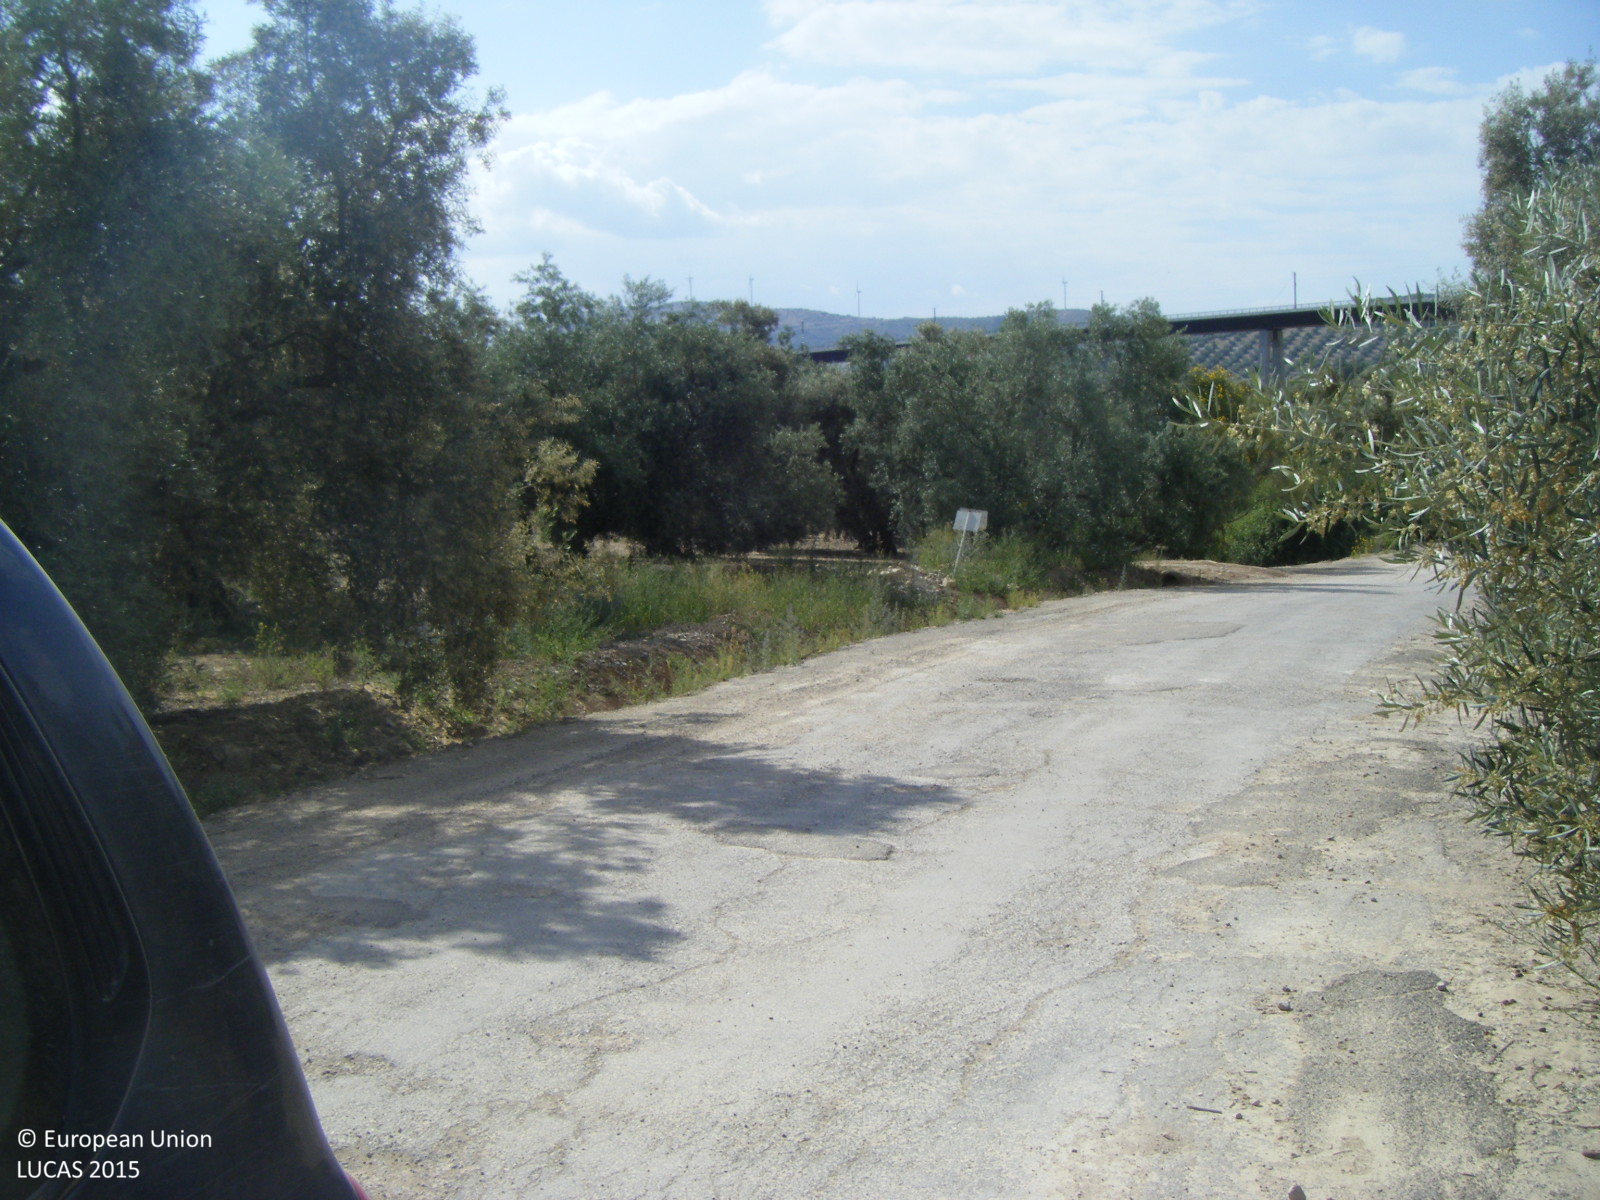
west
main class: Cropland
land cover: Olive groves
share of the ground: 10 - 25 %
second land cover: Other bare soil
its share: > 75 %
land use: Agriculture (excluding fallow land and kitchen gardens)
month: May
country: ES
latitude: 37.1246
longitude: -4.3923
